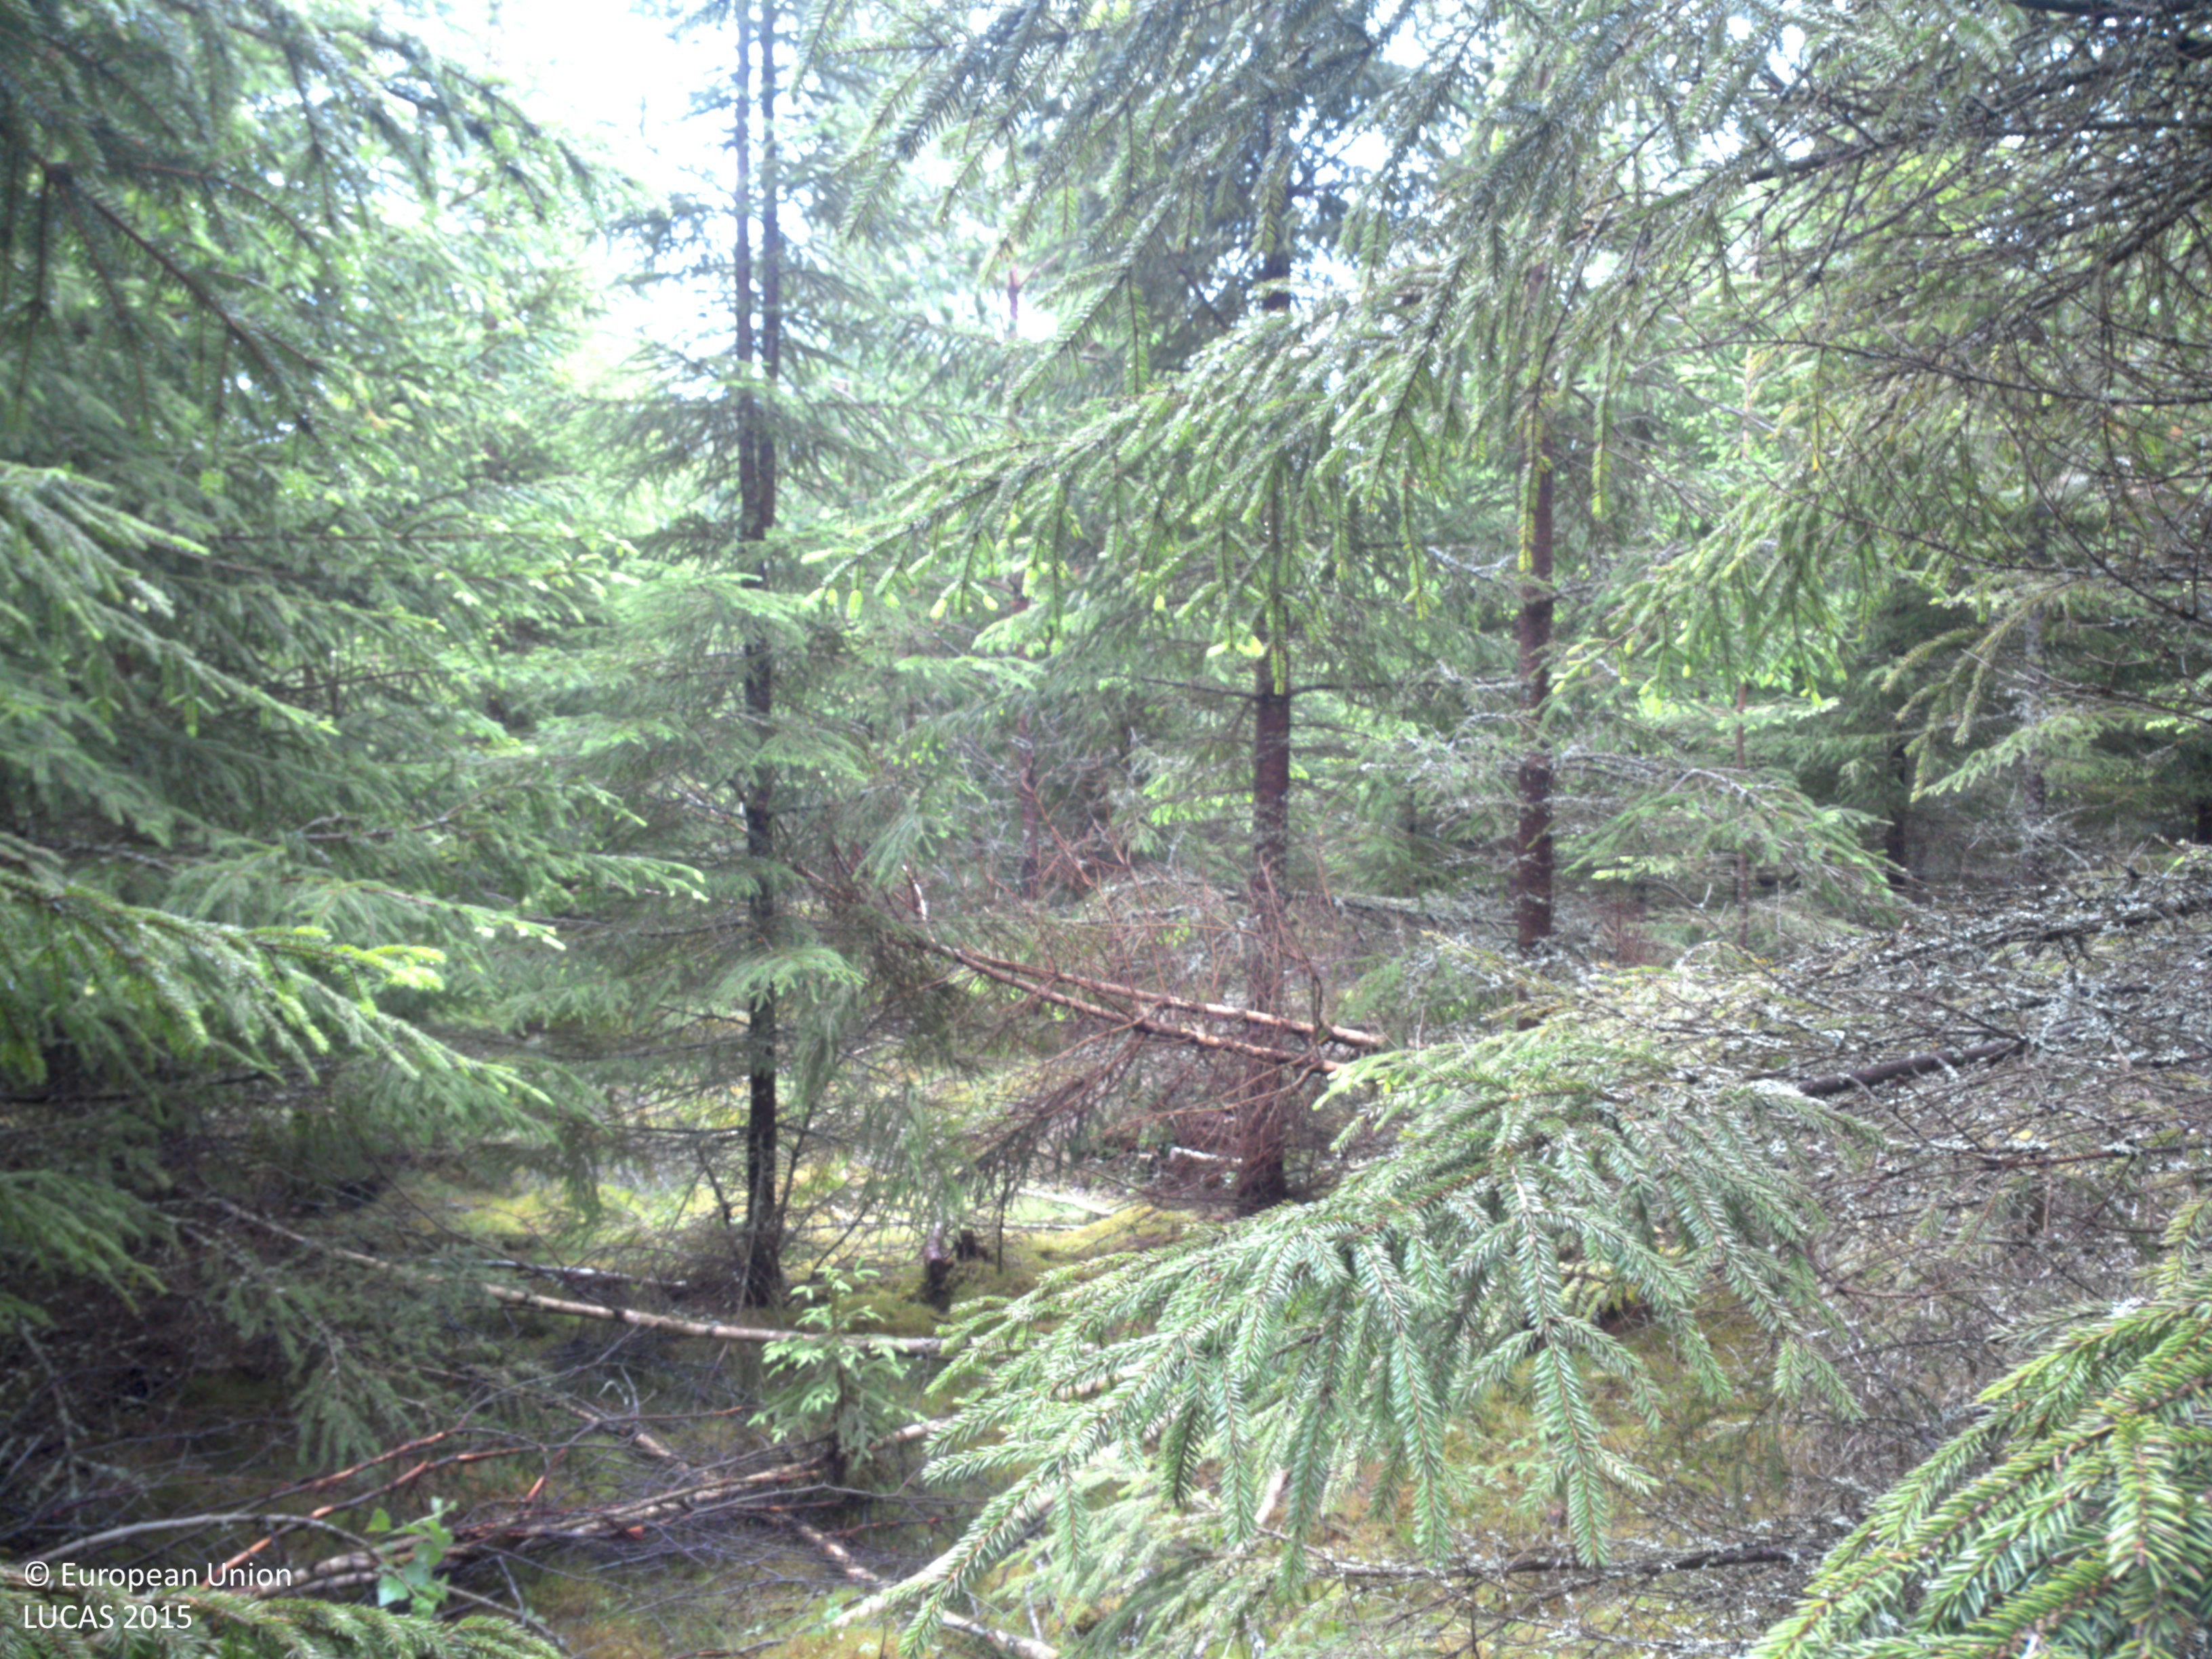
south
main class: Woodland
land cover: Spruce dominated coniferous woodland
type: boreal forest
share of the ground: > 75 %
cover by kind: coniferous forest trees 75 %, lichens and mosses 25 %
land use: Forestry
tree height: < 5 m
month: July
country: SE
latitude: 58.8325
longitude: 12.1260
